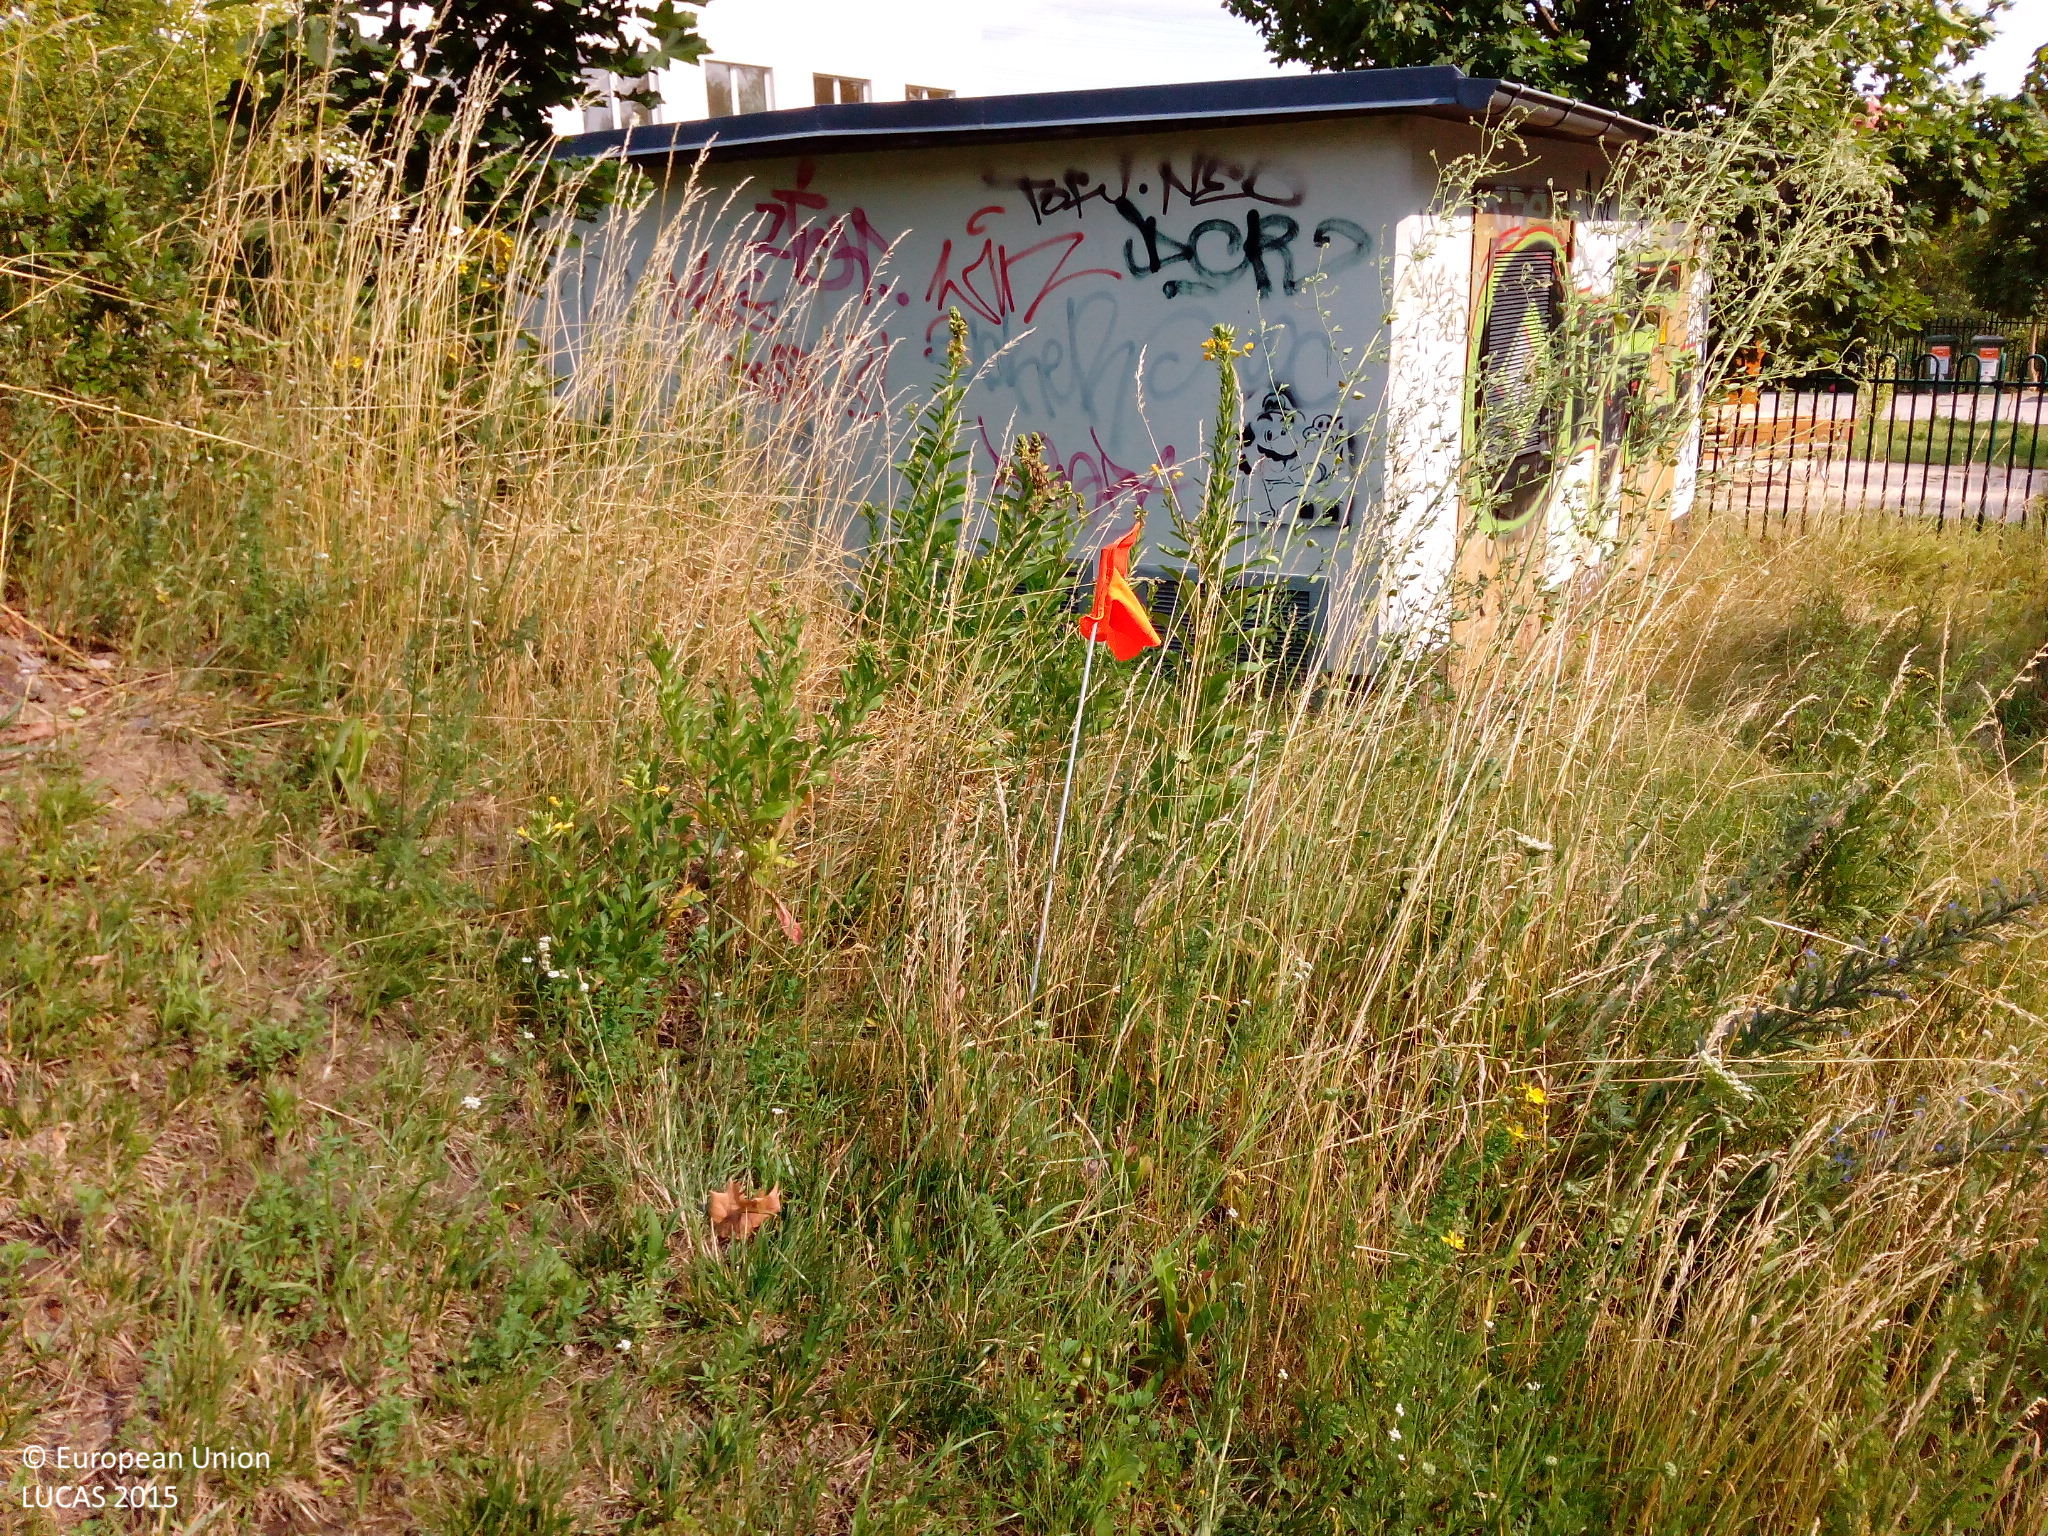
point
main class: Grassland
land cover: Grassland without tree/shrub cover
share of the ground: > 75 %
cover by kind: consolidated bare surface 75 %, herbaceous plants 25 %
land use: Semi-natural and natural areas not in use
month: July
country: DE
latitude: 52.5385
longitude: 13.6125
